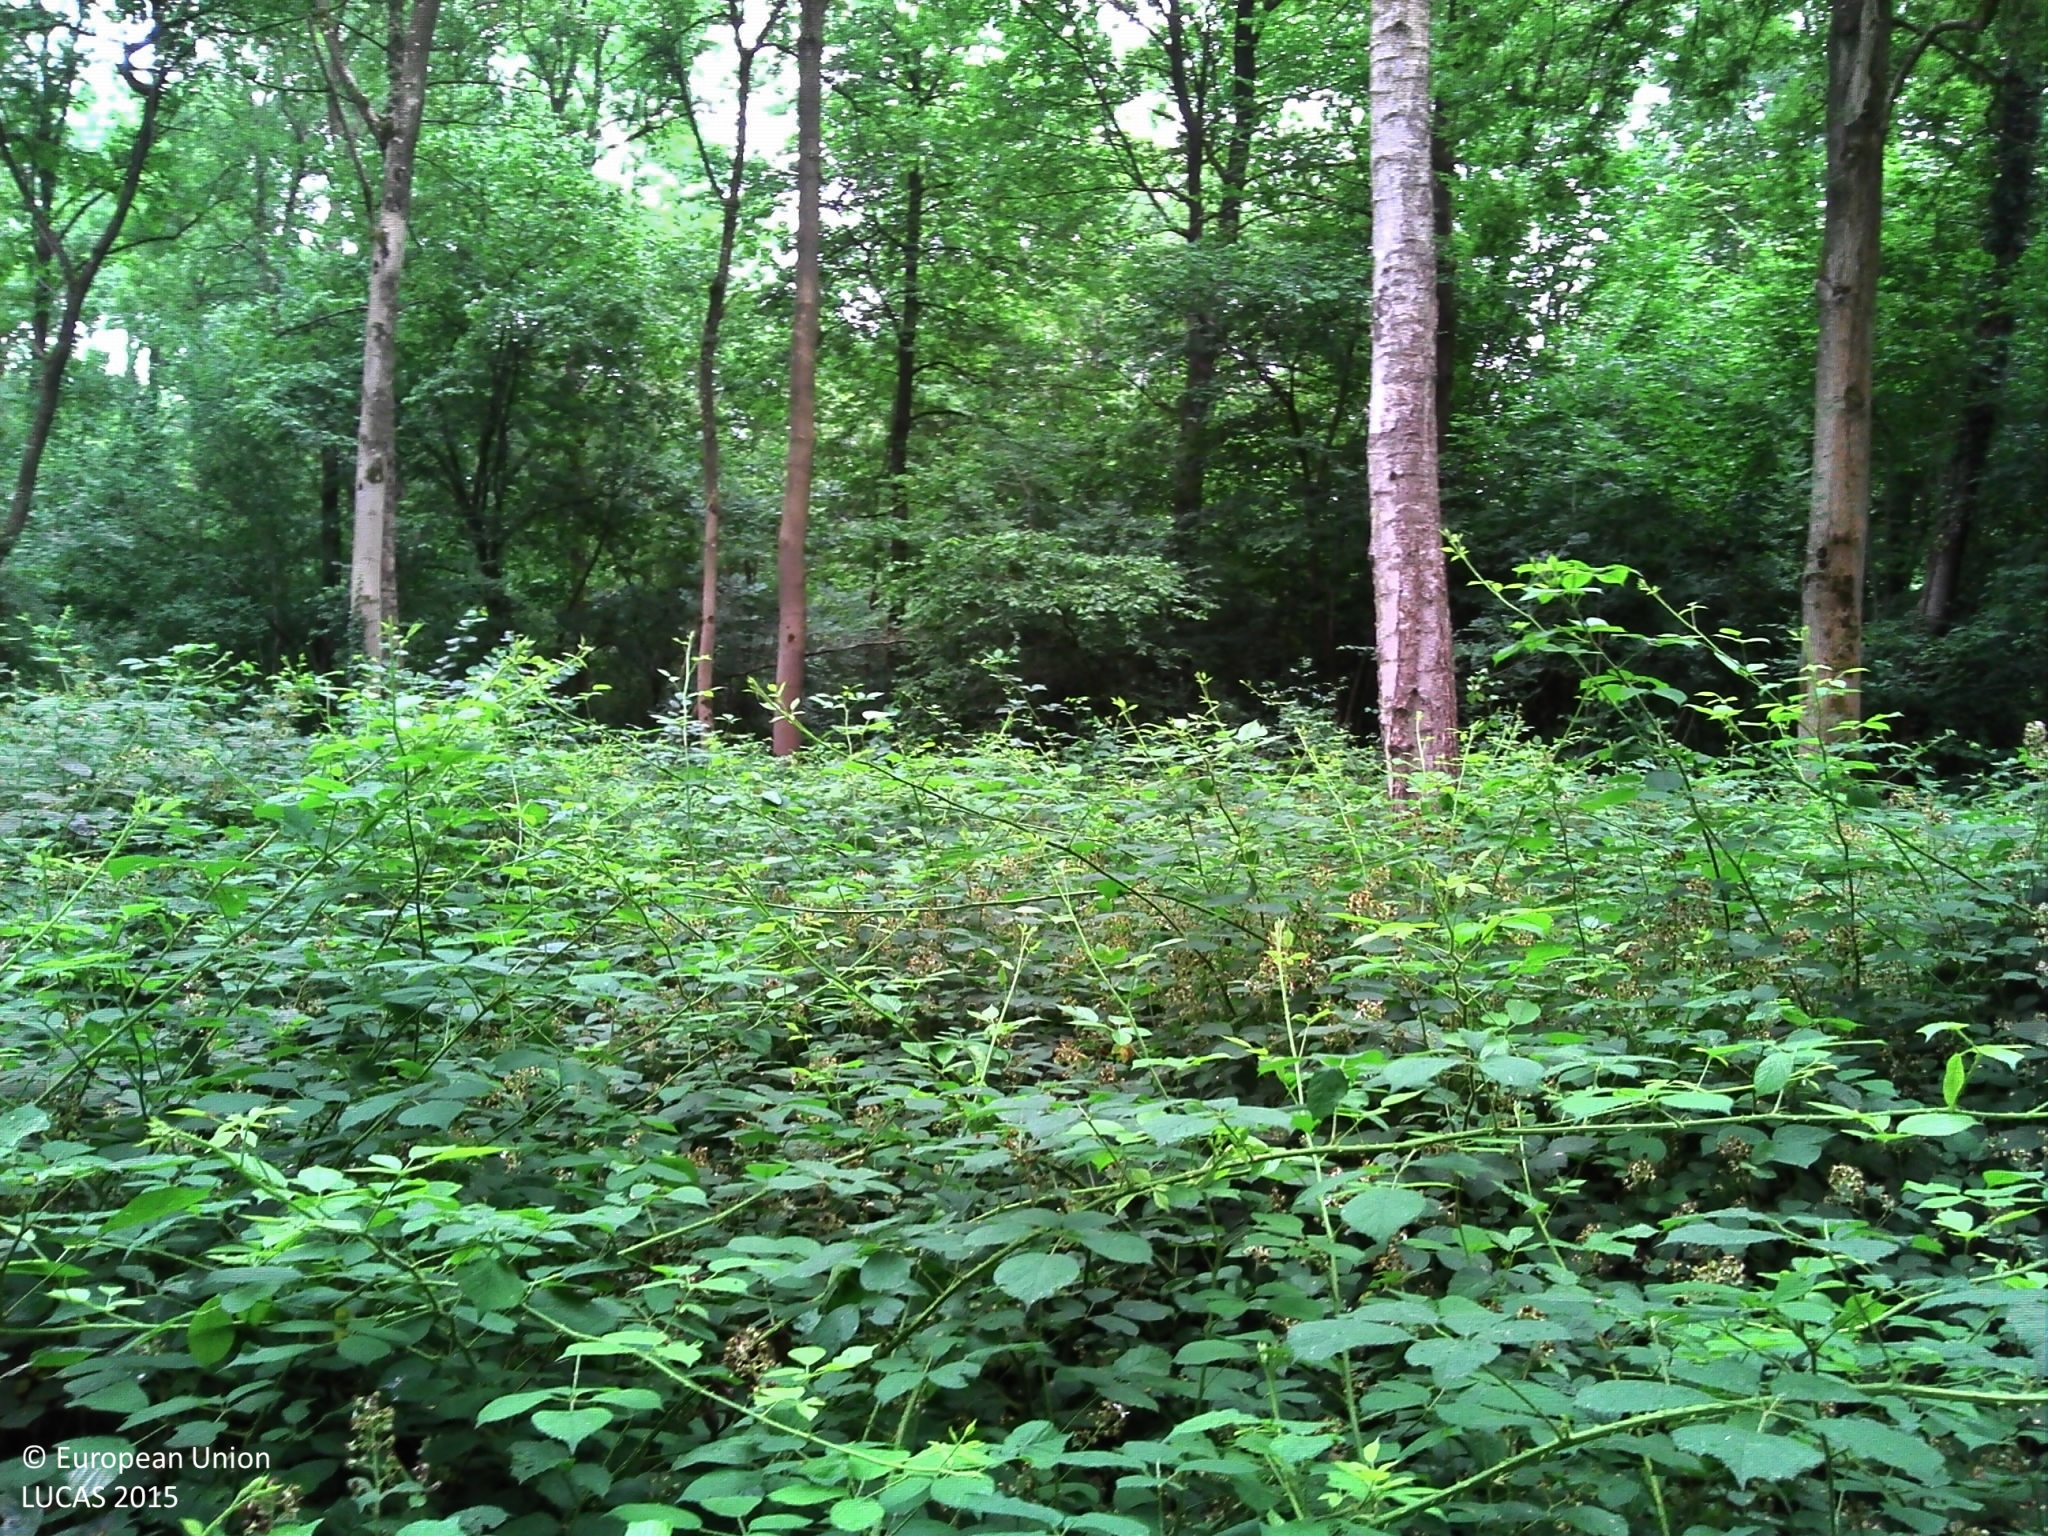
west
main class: Woodland
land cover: Broadleaved woodland
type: mesophytic deciduous forest
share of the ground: > 75 %
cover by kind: broadleaved forest trees 70 %, shrubs 15 %, herbaceous plants 15 %
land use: Forestry
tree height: > 5 m
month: July
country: FR
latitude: 49.3835
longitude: 1.8152
